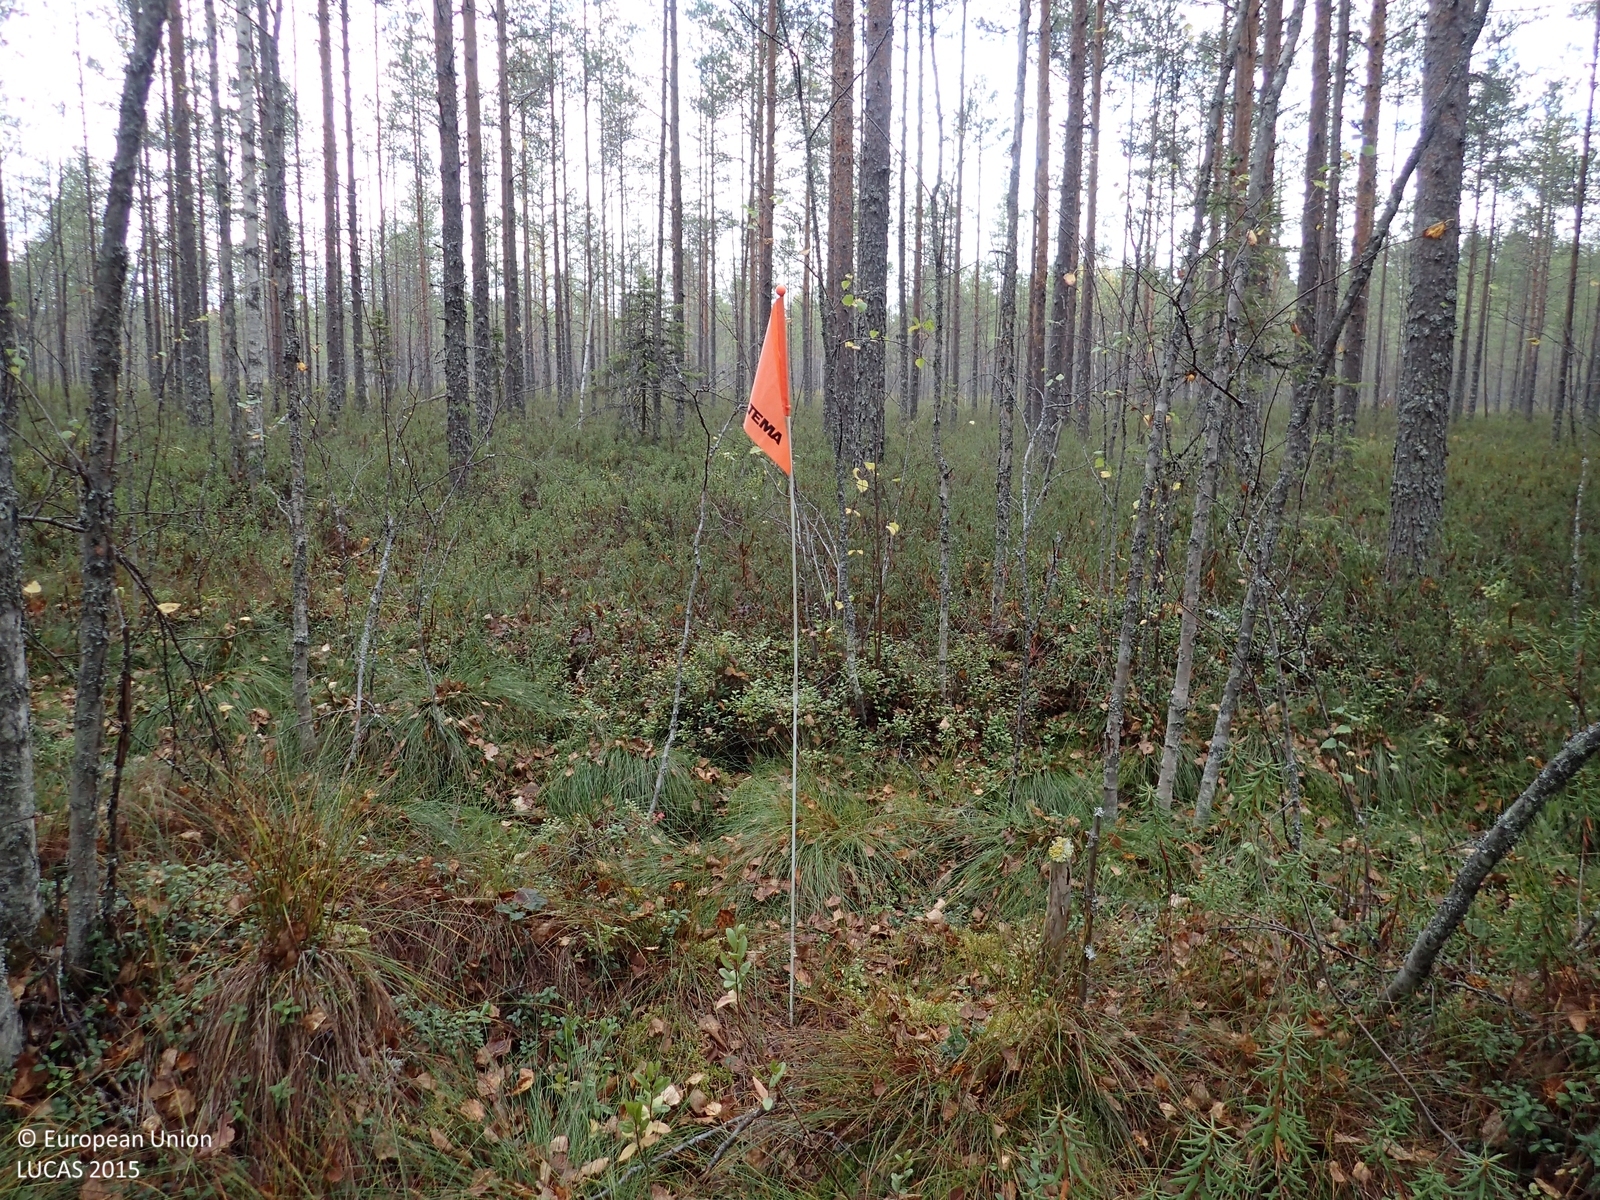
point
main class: Woodland
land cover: Pine dominated mixed woodland
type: mire and swamp forests
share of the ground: > 75 %
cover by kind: coniferous forest trees 55 %, shrubs 25 %, broadleaved forest trees 20 %
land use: Forestry
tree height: > 5 m
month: September
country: FI
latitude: 63.3225
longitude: 25.2503
